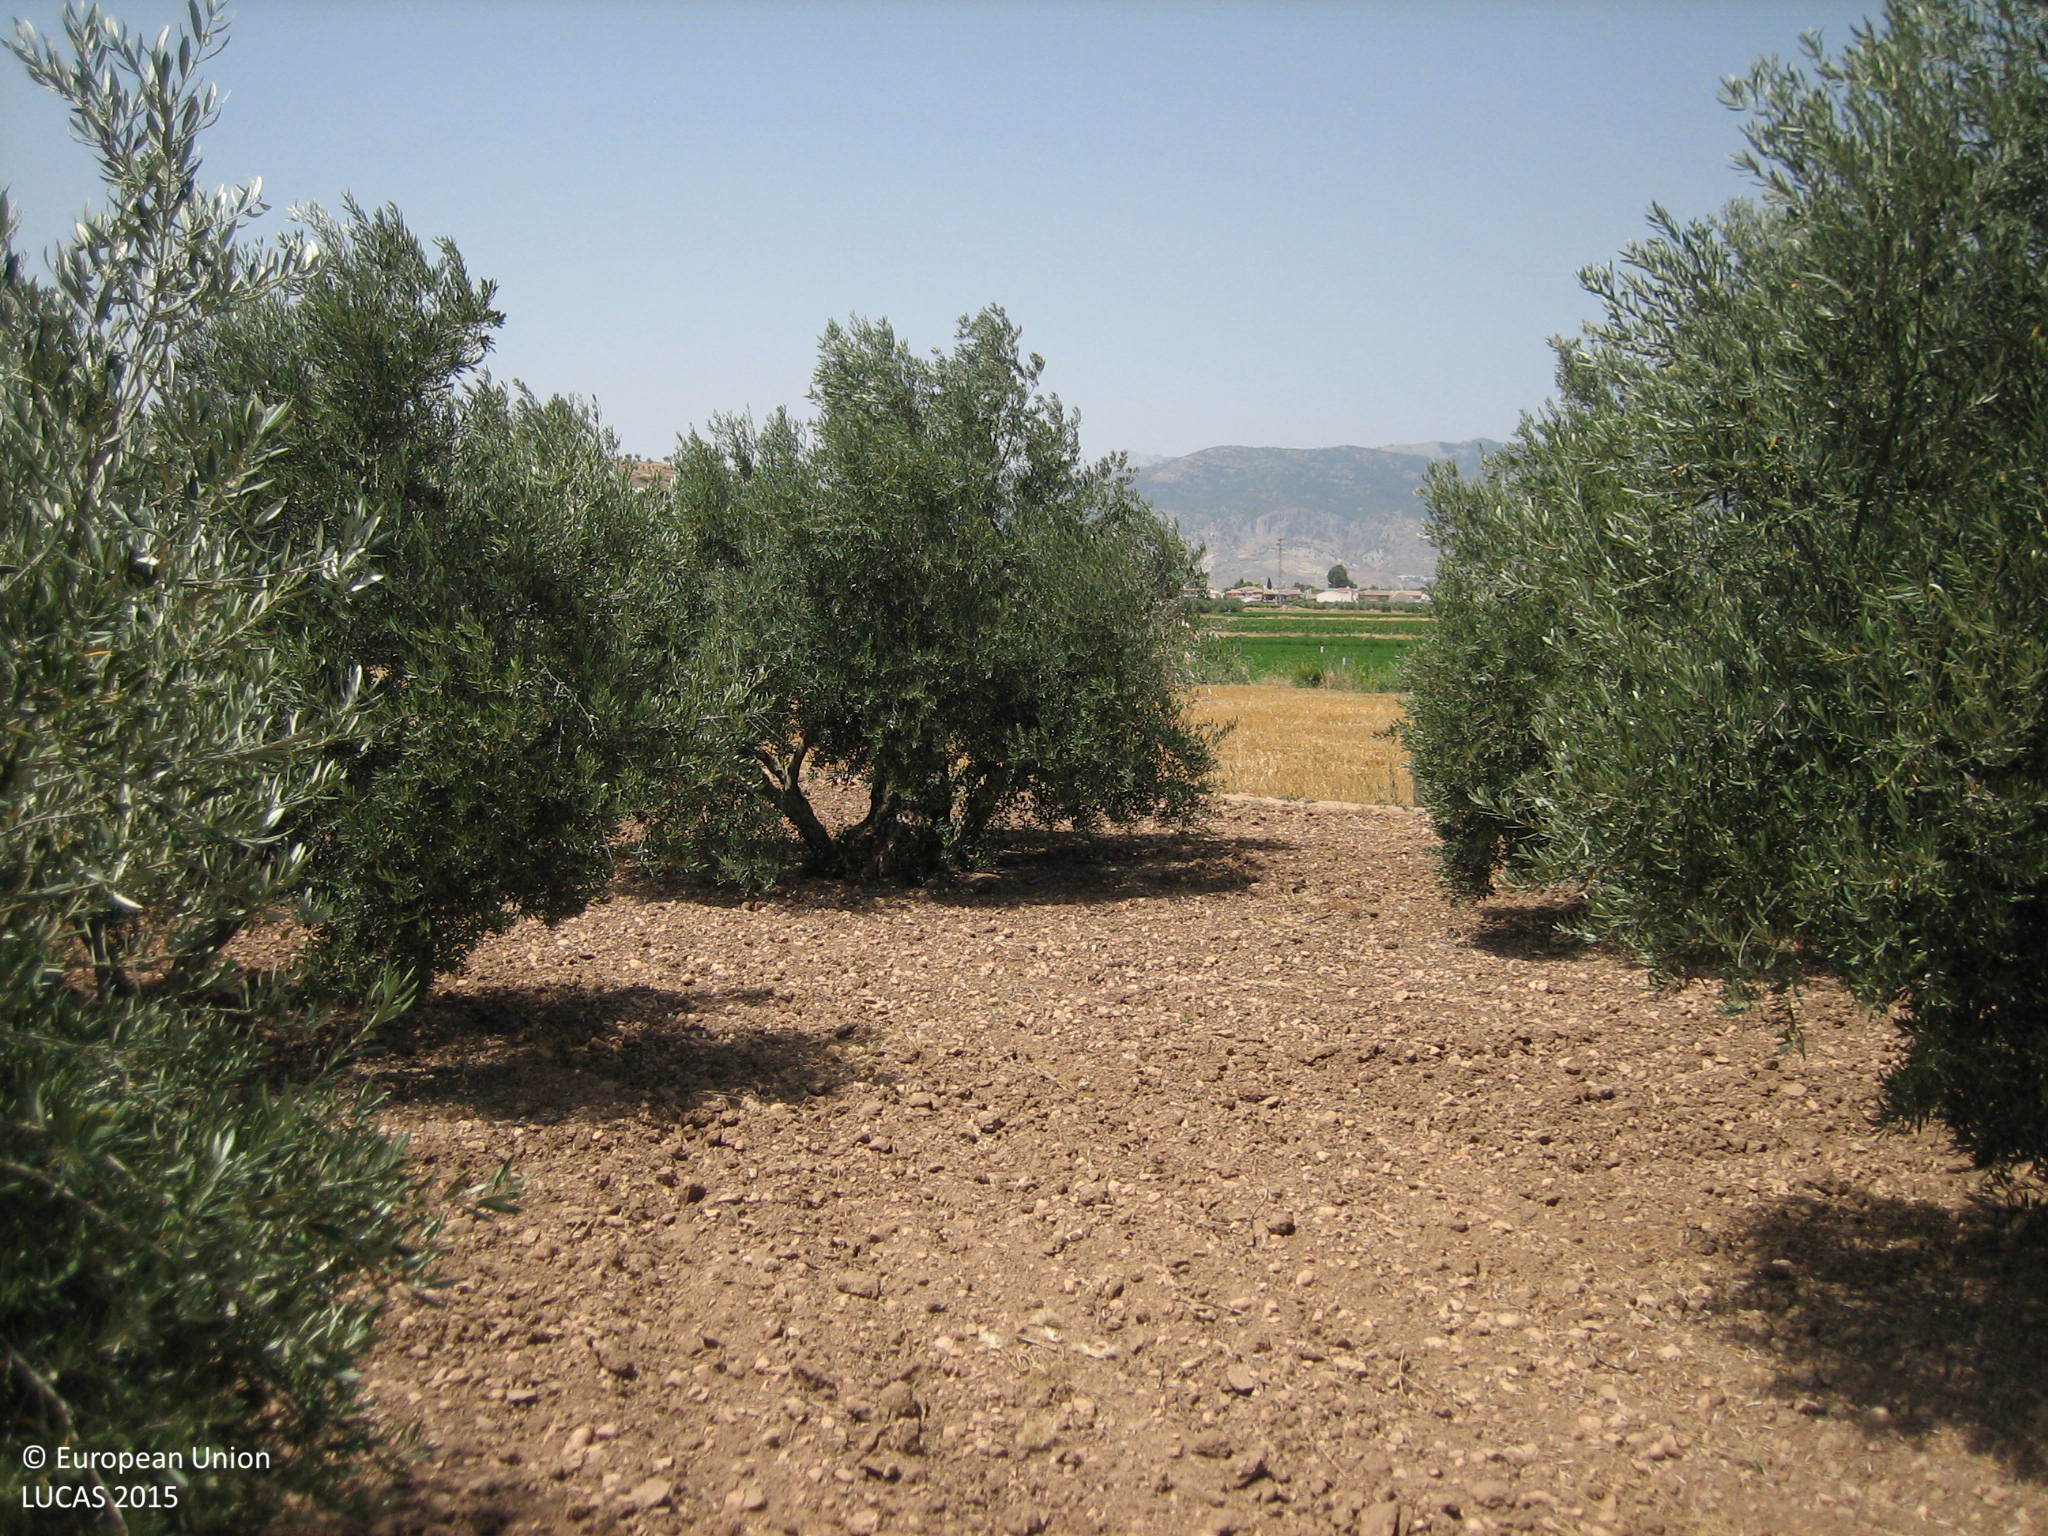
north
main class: Cropland
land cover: Olive groves
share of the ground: 10 - 25 %
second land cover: Other bare soil
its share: > 75 %
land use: Agriculture (excluding fallow land and kitchen gardens)
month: July
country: ES
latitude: 37.6621
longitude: -2.9710
